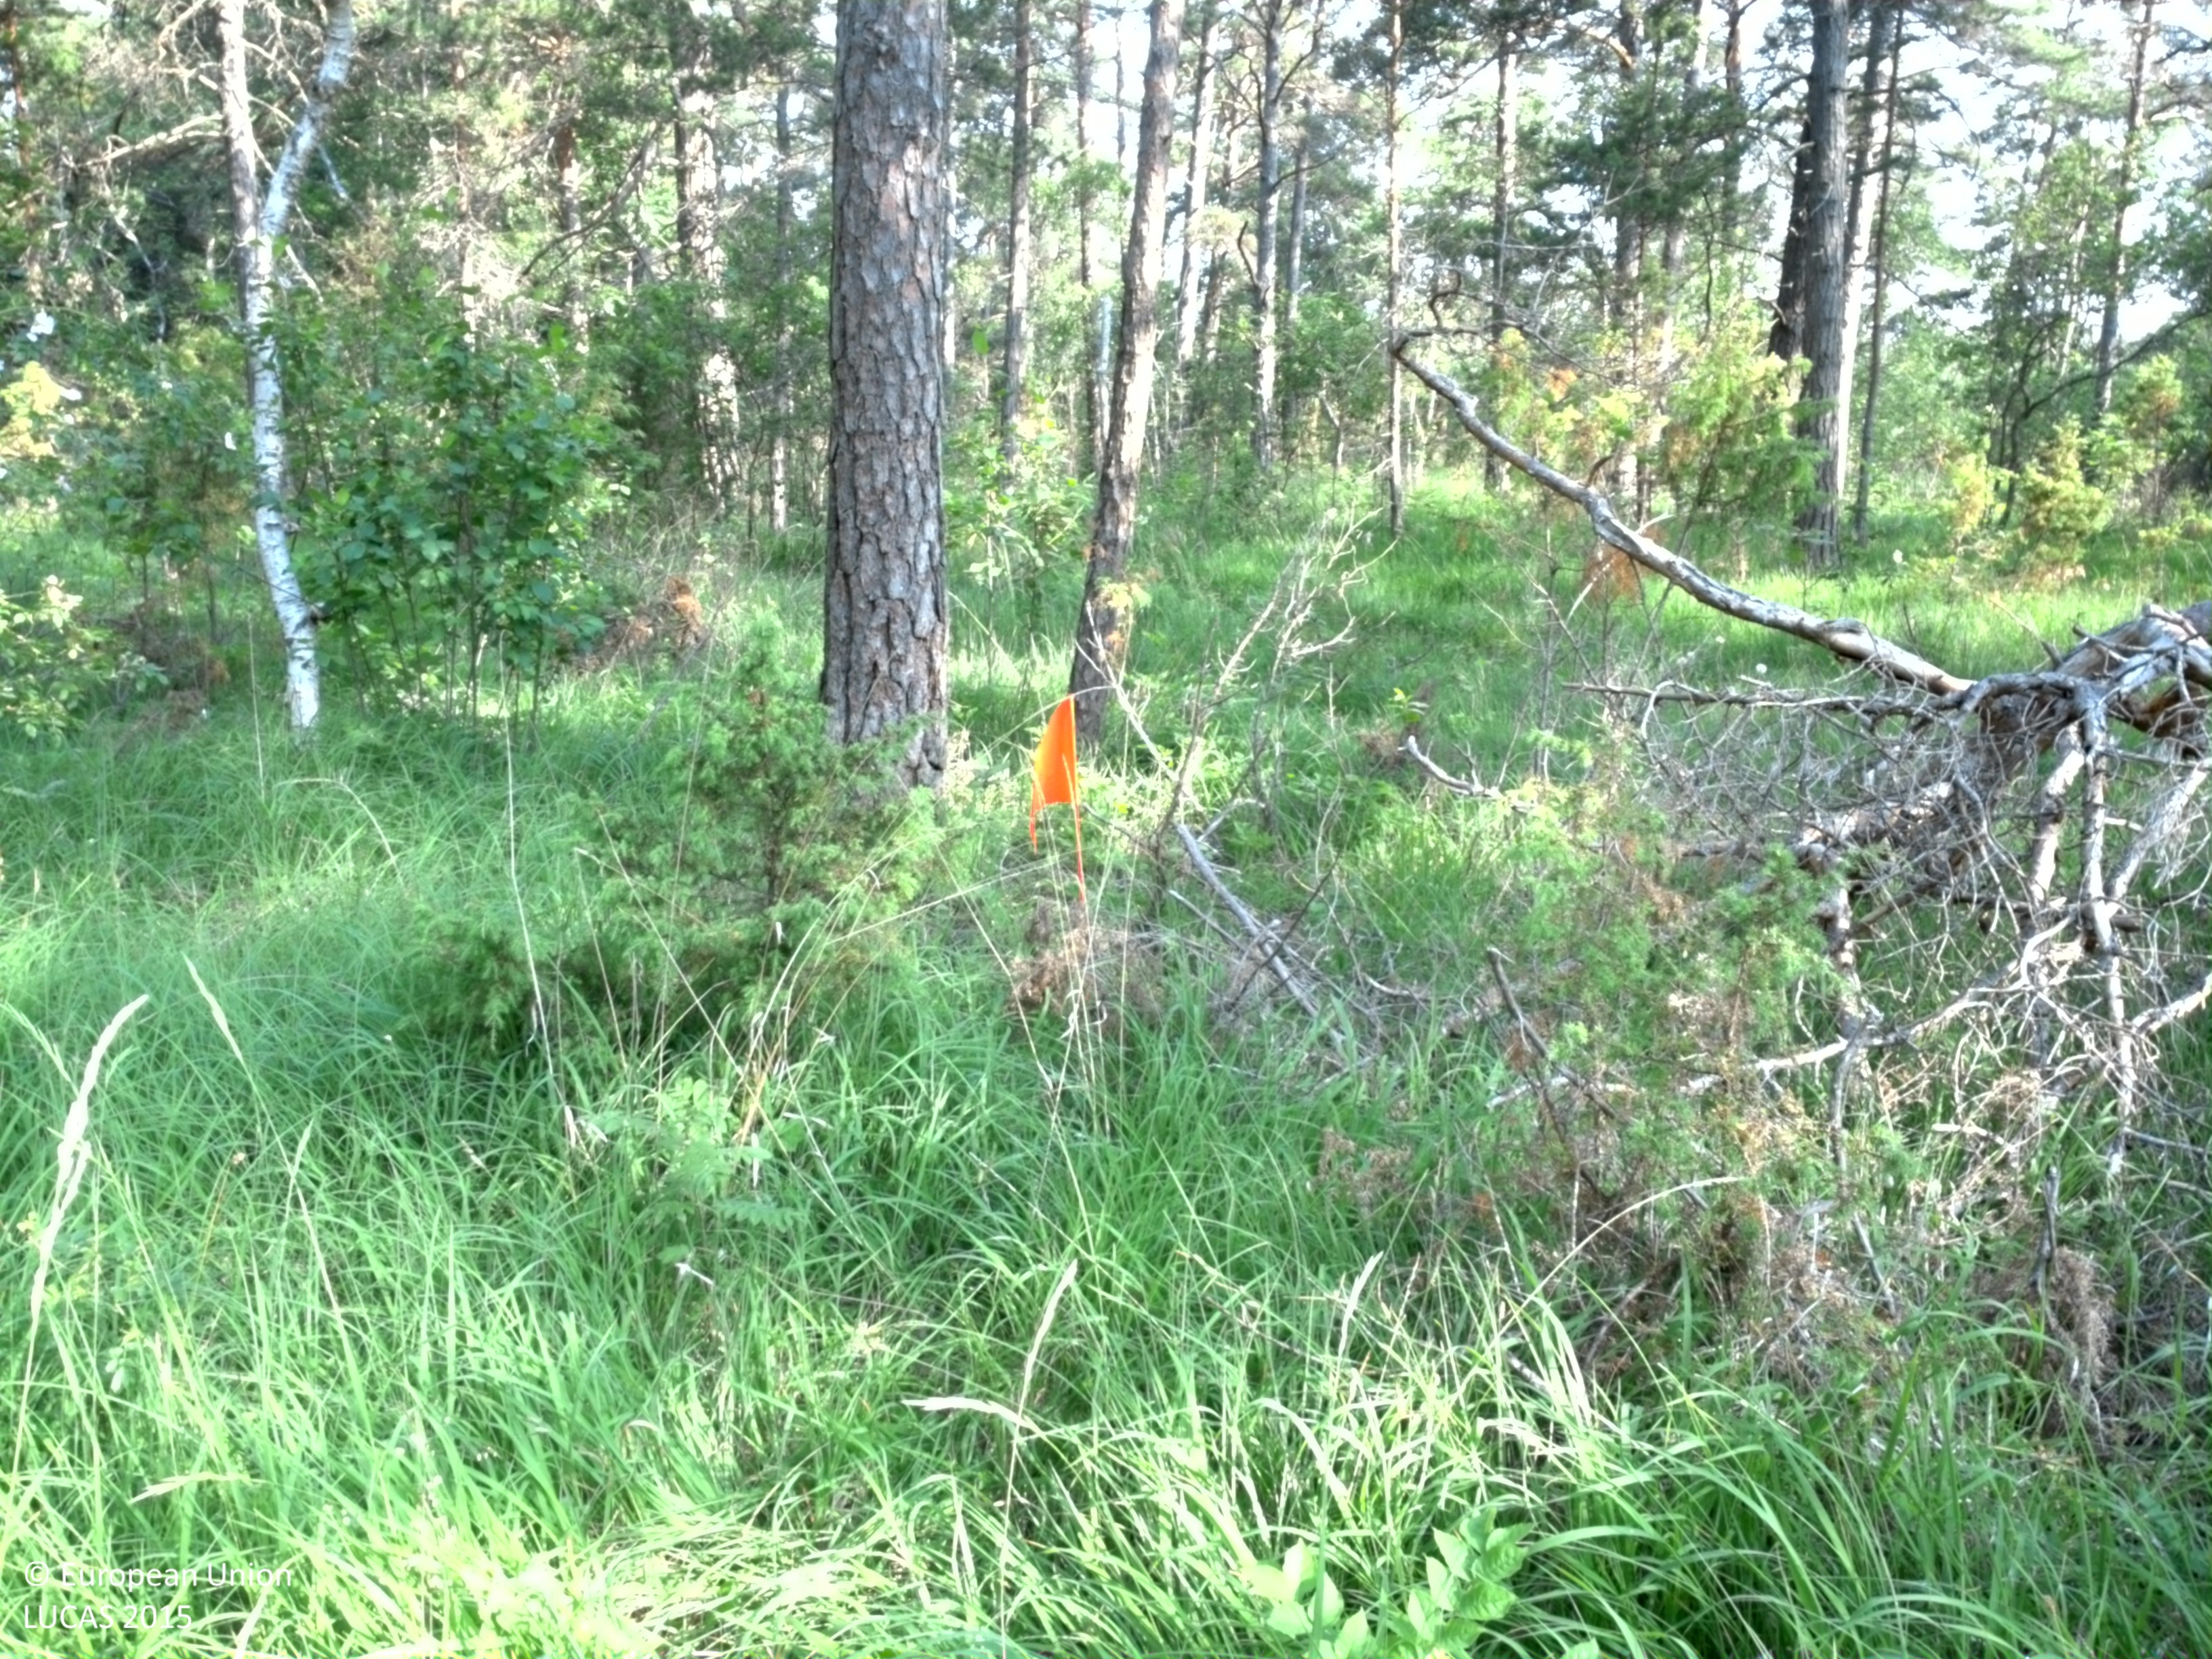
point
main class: Woodland
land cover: Pine dominated coniferous woodland
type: hemiboreal forest and nemoral coniferous forest and mixed broadleaved-coniferous forest
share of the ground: 50 - 75 %
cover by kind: coniferous forest trees 70 %, shrubs 15 %, herbaceous plants 15 %
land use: Forestry
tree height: > 5 m
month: July
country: SE
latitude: 57.6806
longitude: 18.7469
